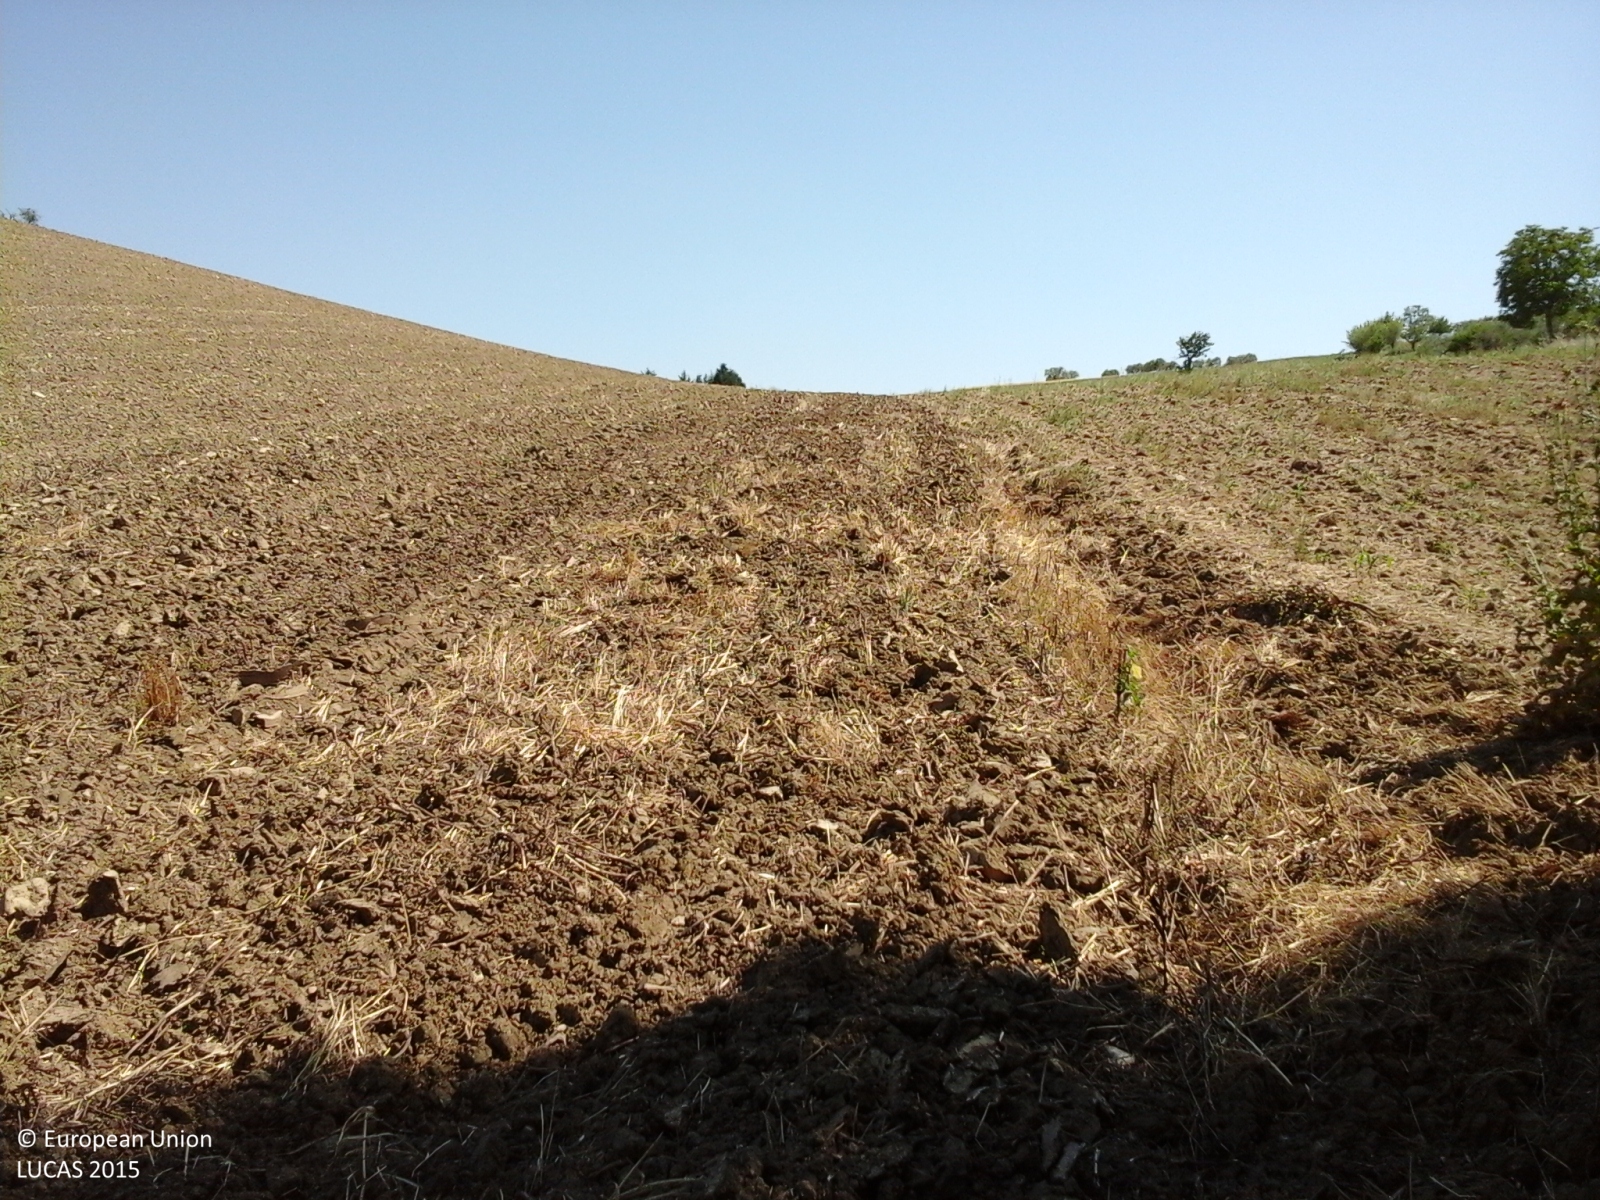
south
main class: Woodland
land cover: Broadleaved woodland
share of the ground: > 75 %
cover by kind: broadleaved forest trees 85 %, shrubs 10 %, herbaceous plants 5 %
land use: Semi-natural and natural areas not in use
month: July
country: IT
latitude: 41.5848
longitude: 14.7218
